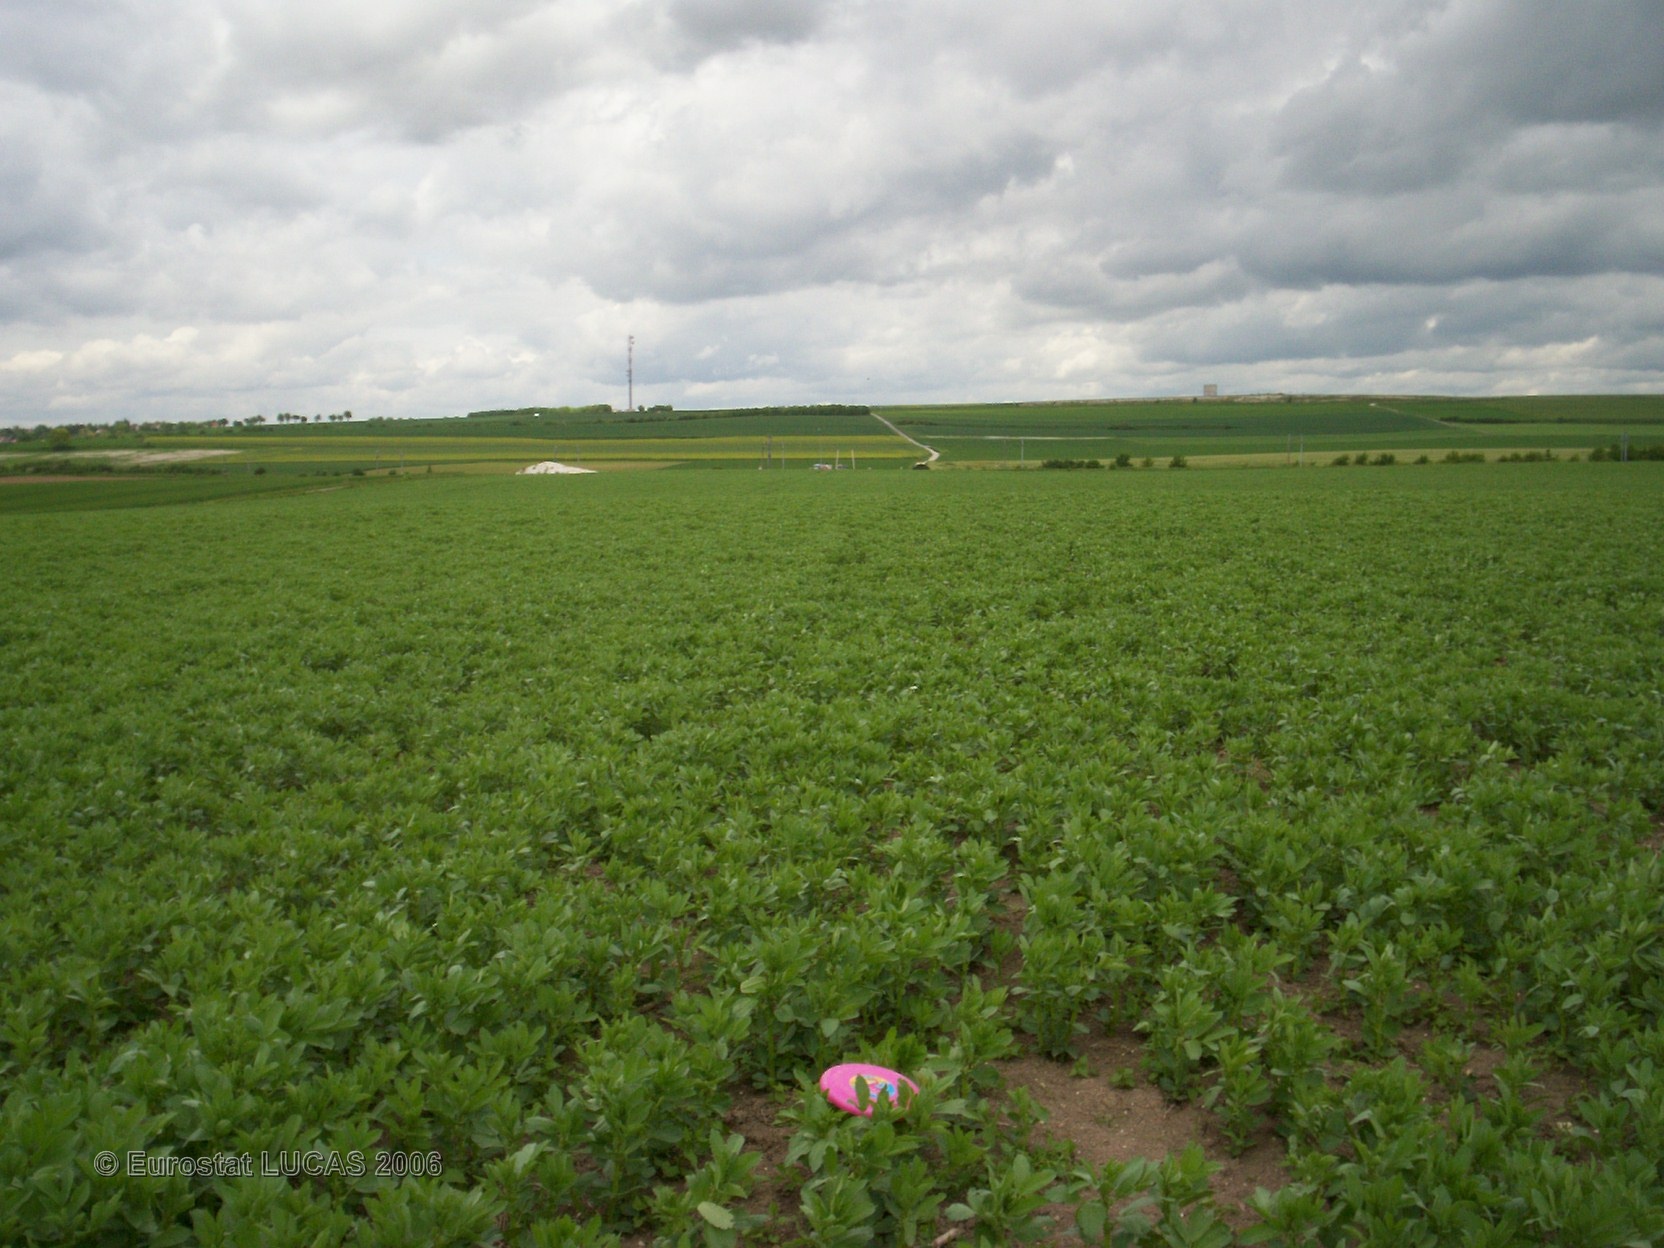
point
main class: Cropland
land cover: Dry pulses
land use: Agriculture (excluding fallow land and kitchen gardens)
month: May
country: FR
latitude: 49.5060
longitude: 4.4031
